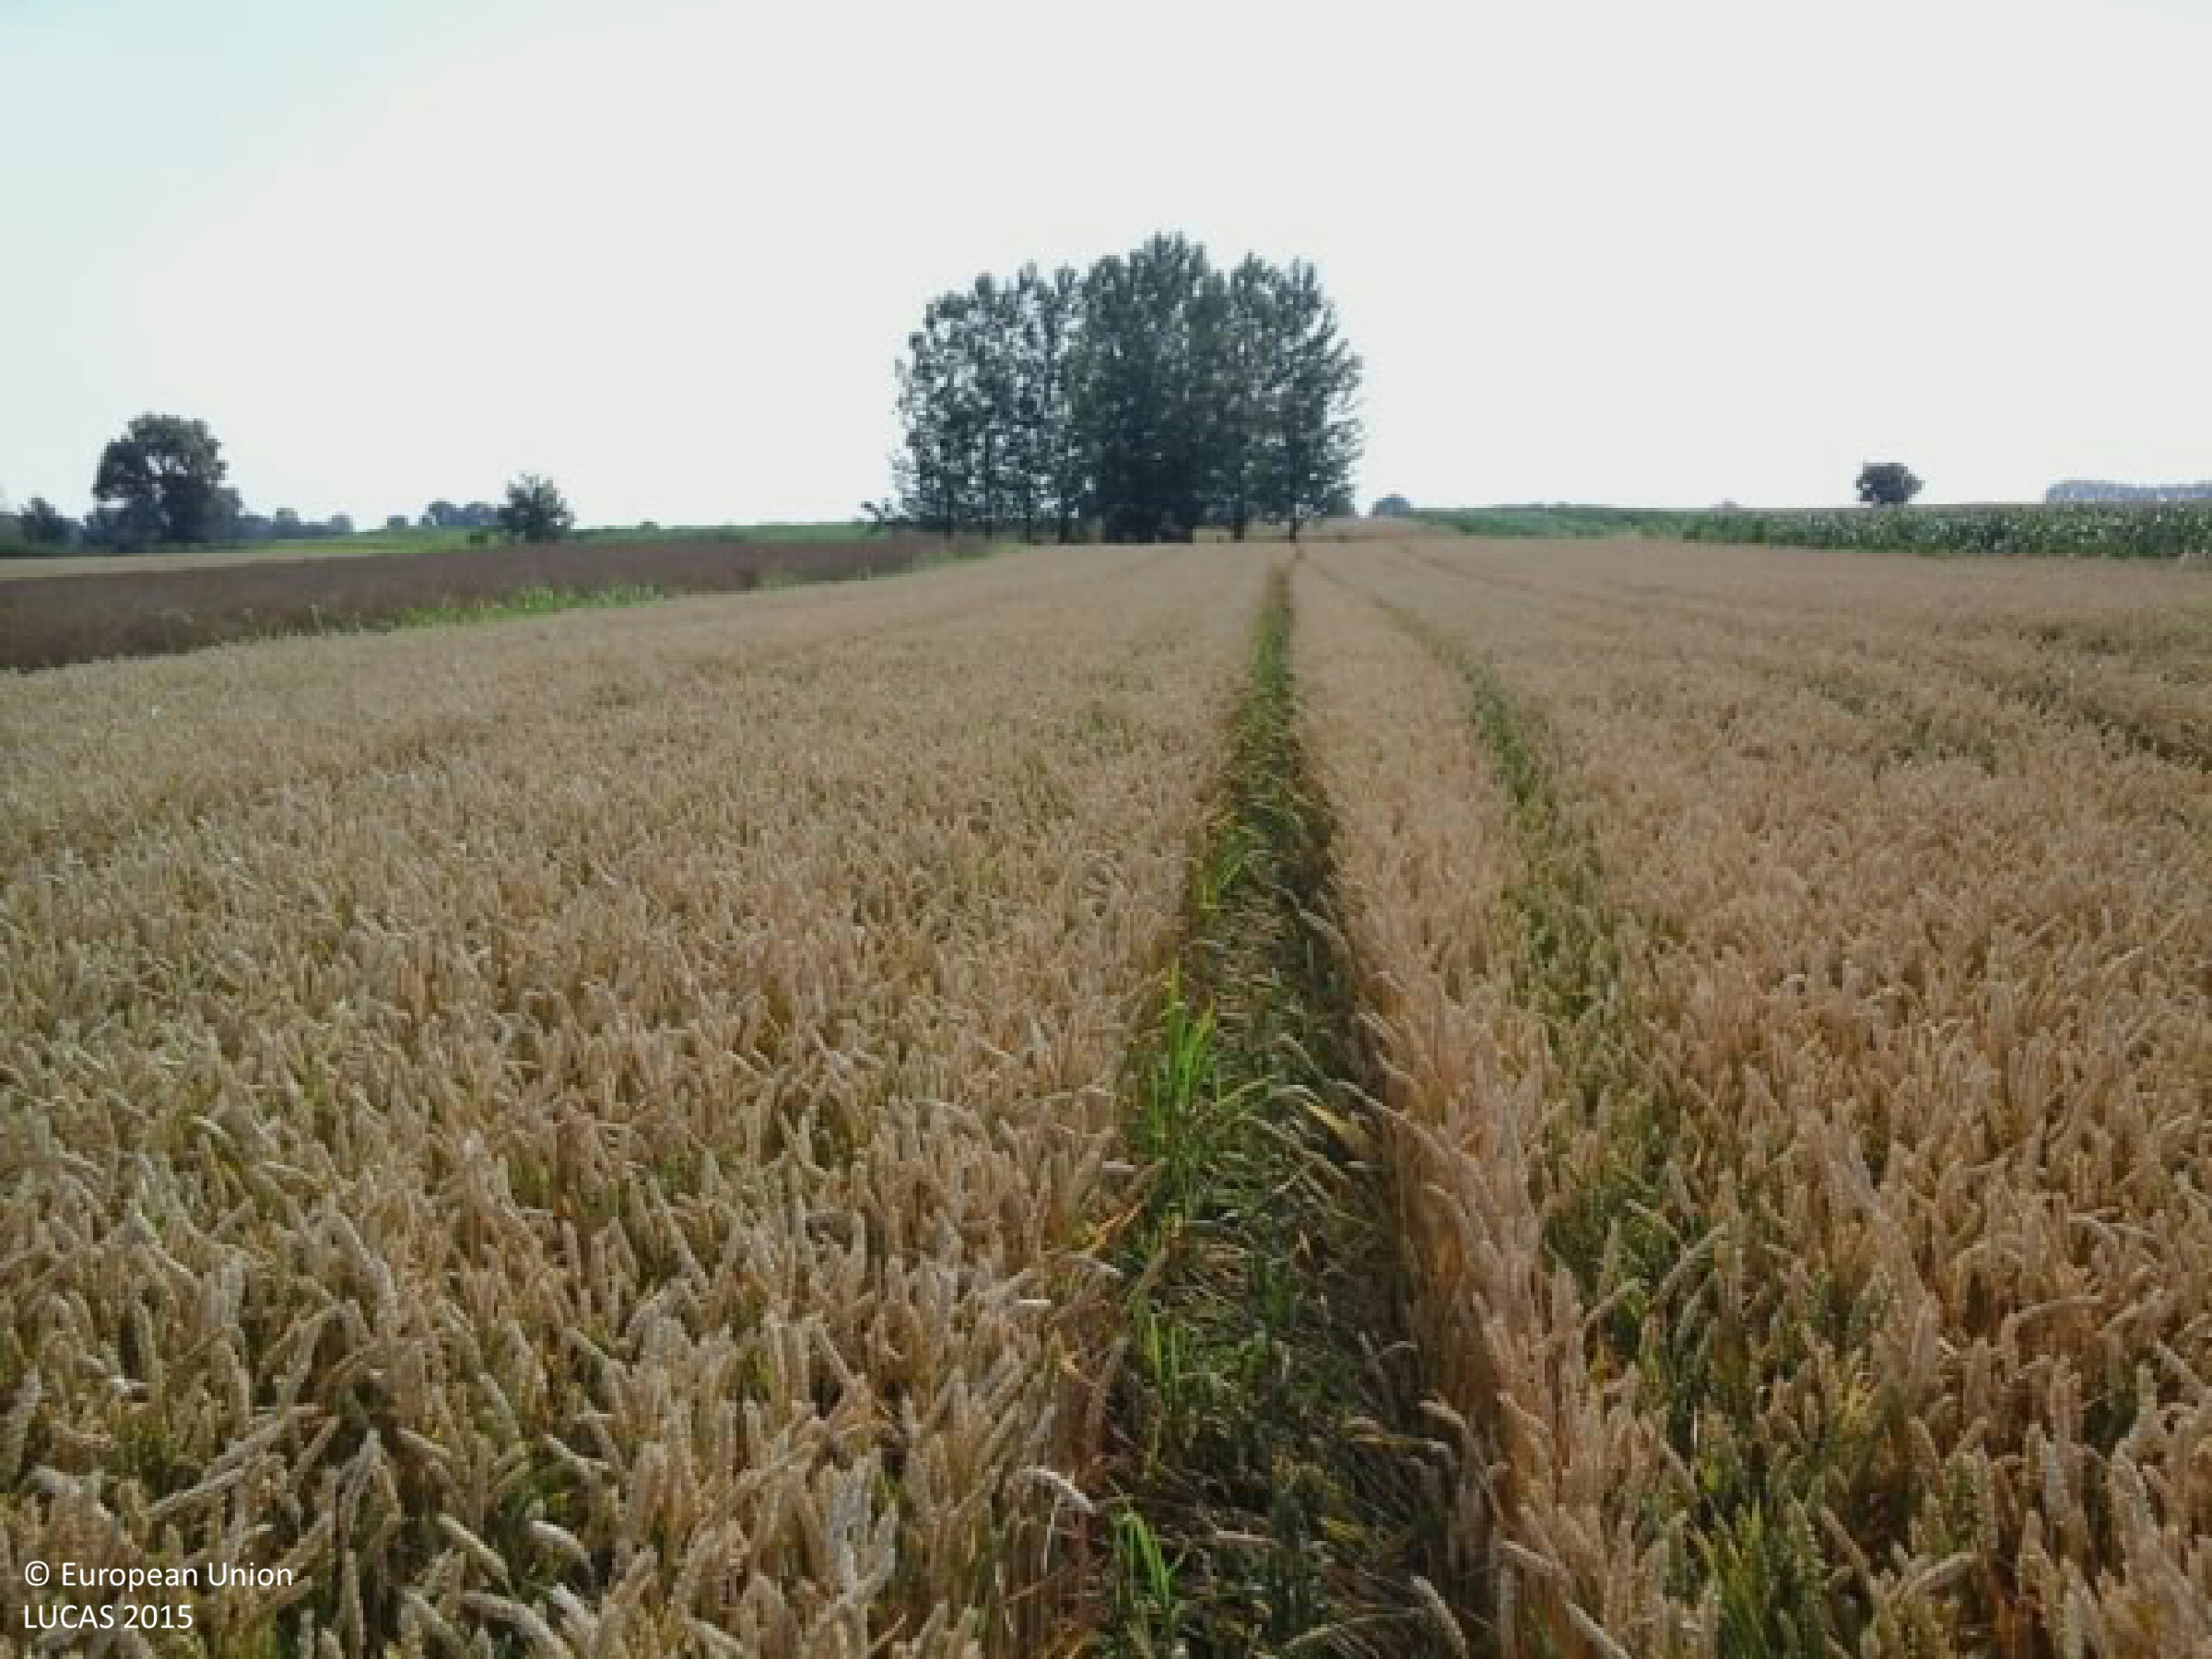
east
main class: Cropland
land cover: Common wheat
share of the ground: > 75 %
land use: Agriculture (excluding fallow land and kitchen gardens)
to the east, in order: Common wheat; Grassland without tree/shrub cover; Maize; Grass margins; Tracks; Grass margins; Soya; Other root crops
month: June
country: HU
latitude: 46.3723
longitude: 18.9698
